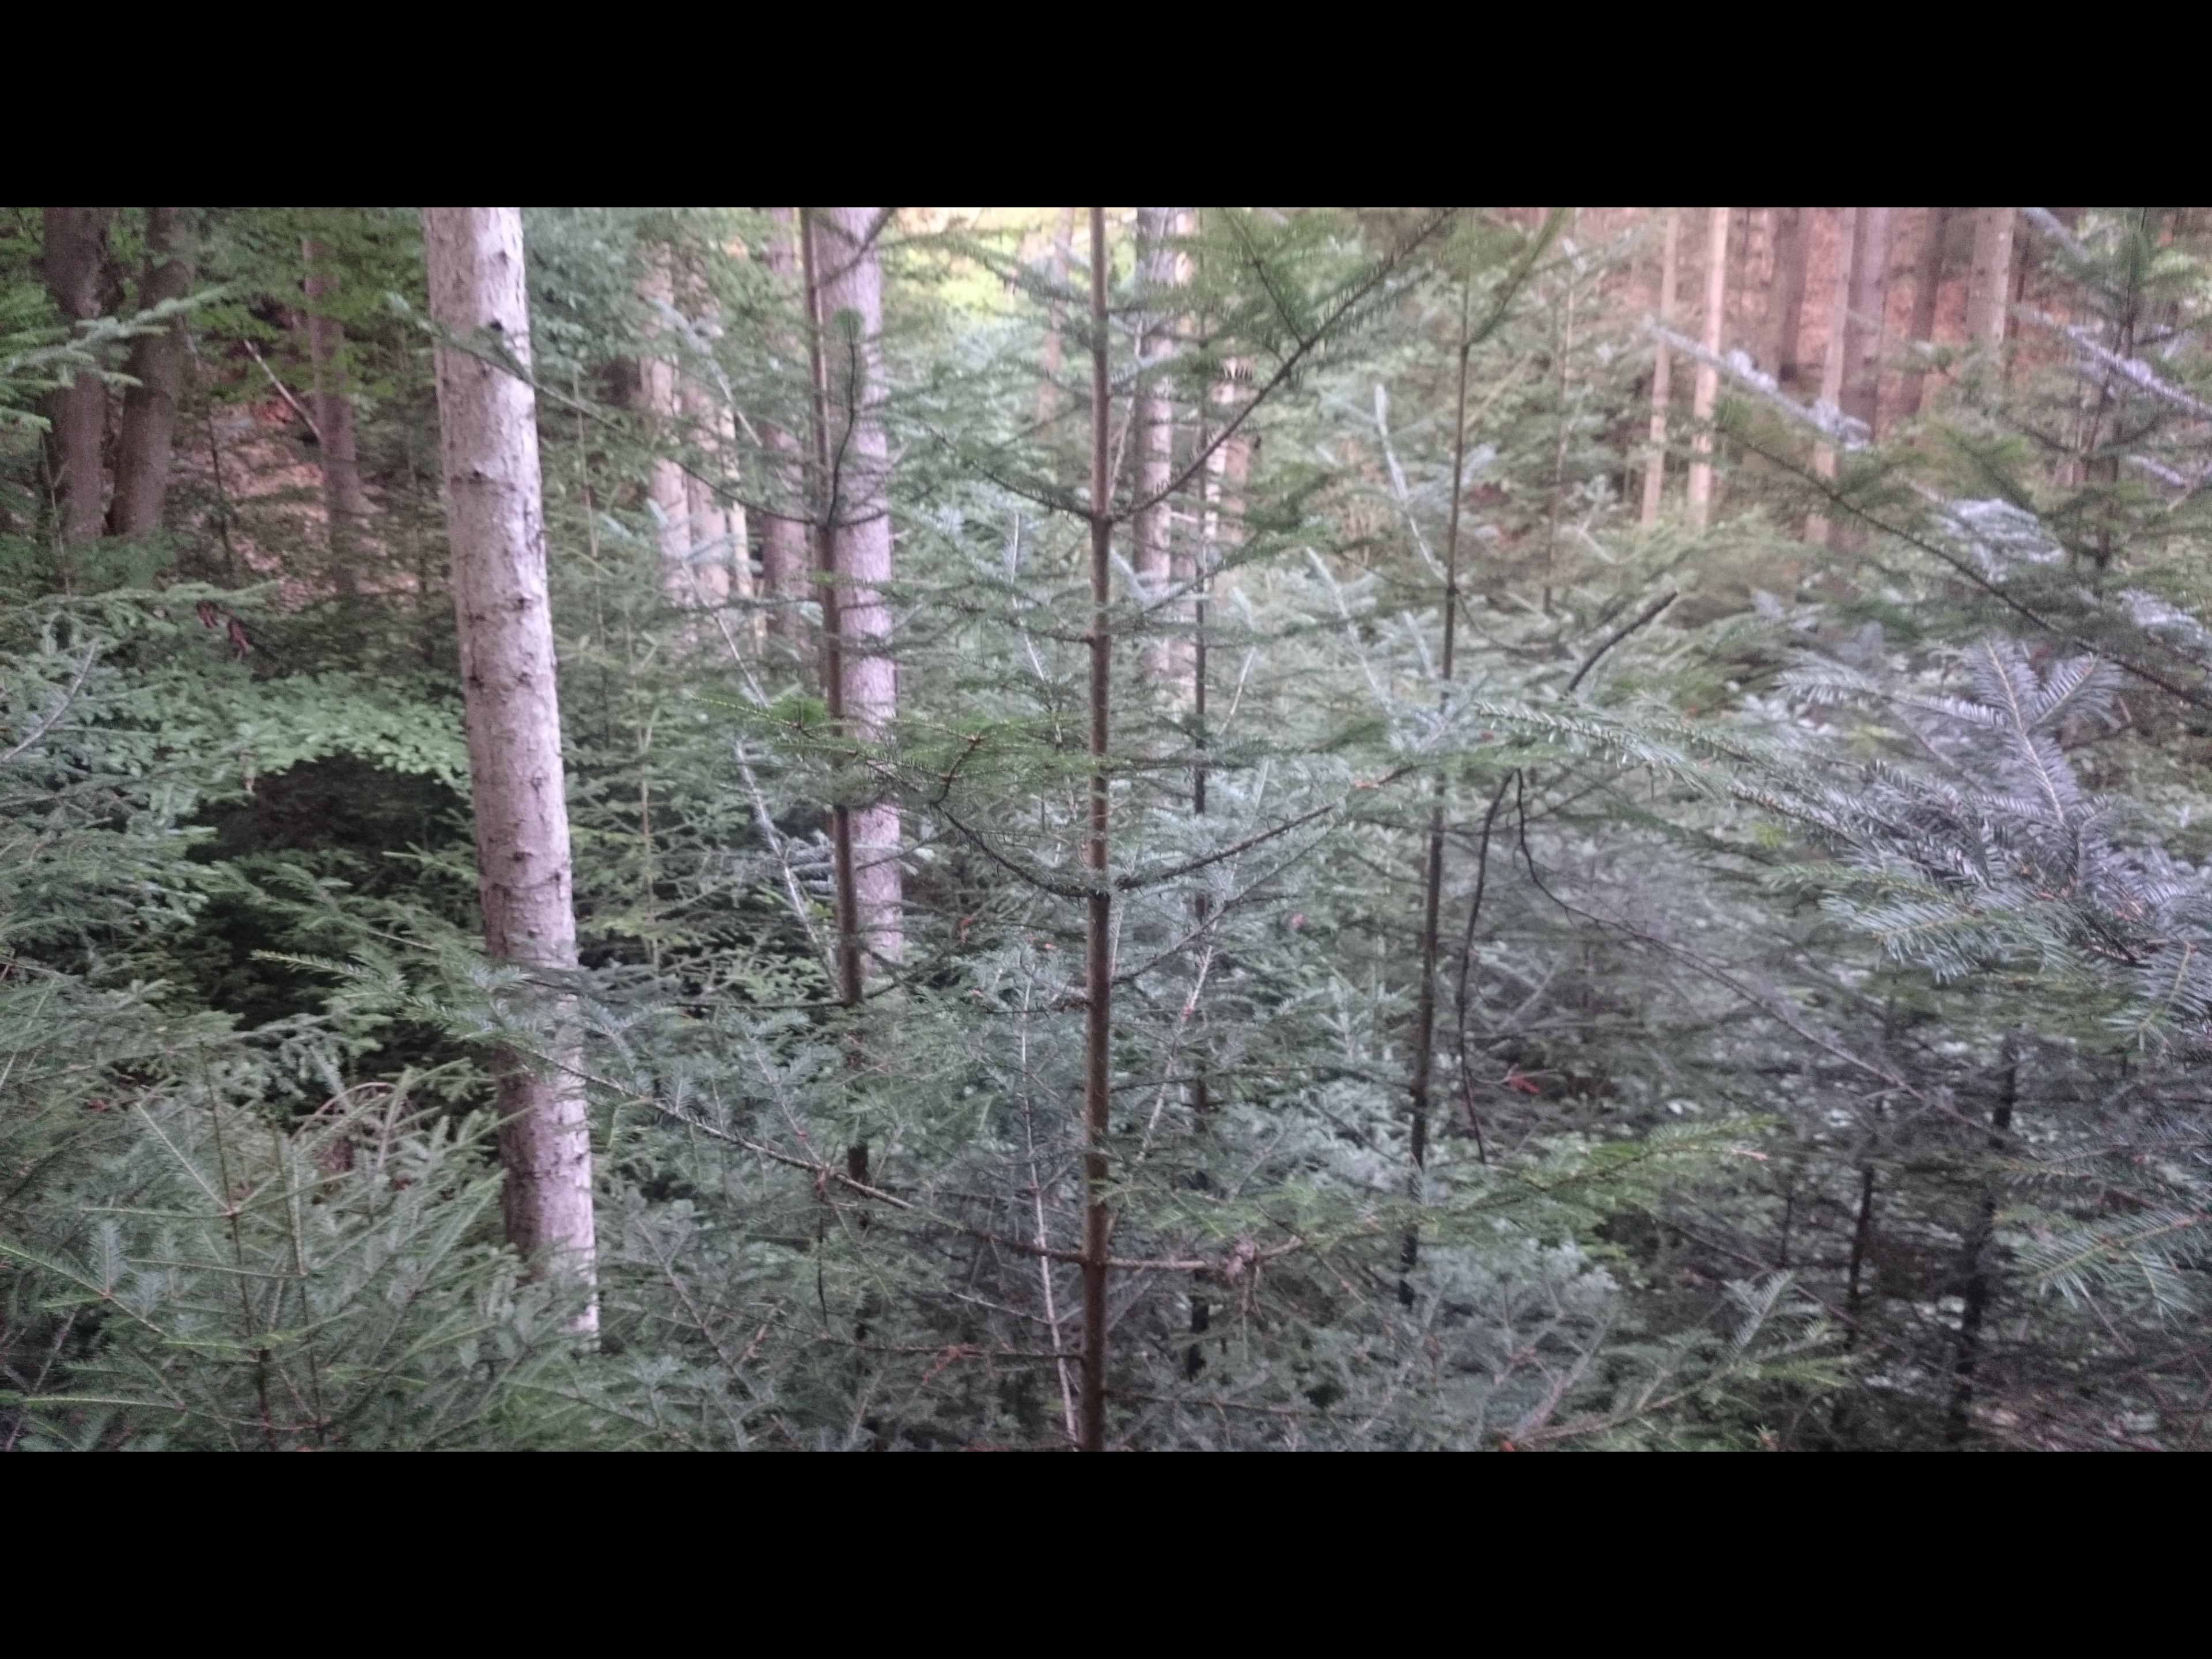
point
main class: Woodland
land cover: Spruce dominated mixed woodland
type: hemiboreal forest and nemoral coniferous forest and mixed broadleaved-coniferous forest
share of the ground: > 75 %
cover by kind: coniferous forest trees 75 %, broadleaved forest trees 25 %
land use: Forestry
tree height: > 5 m
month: July
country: AT
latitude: 47.2823
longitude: 15.6991
